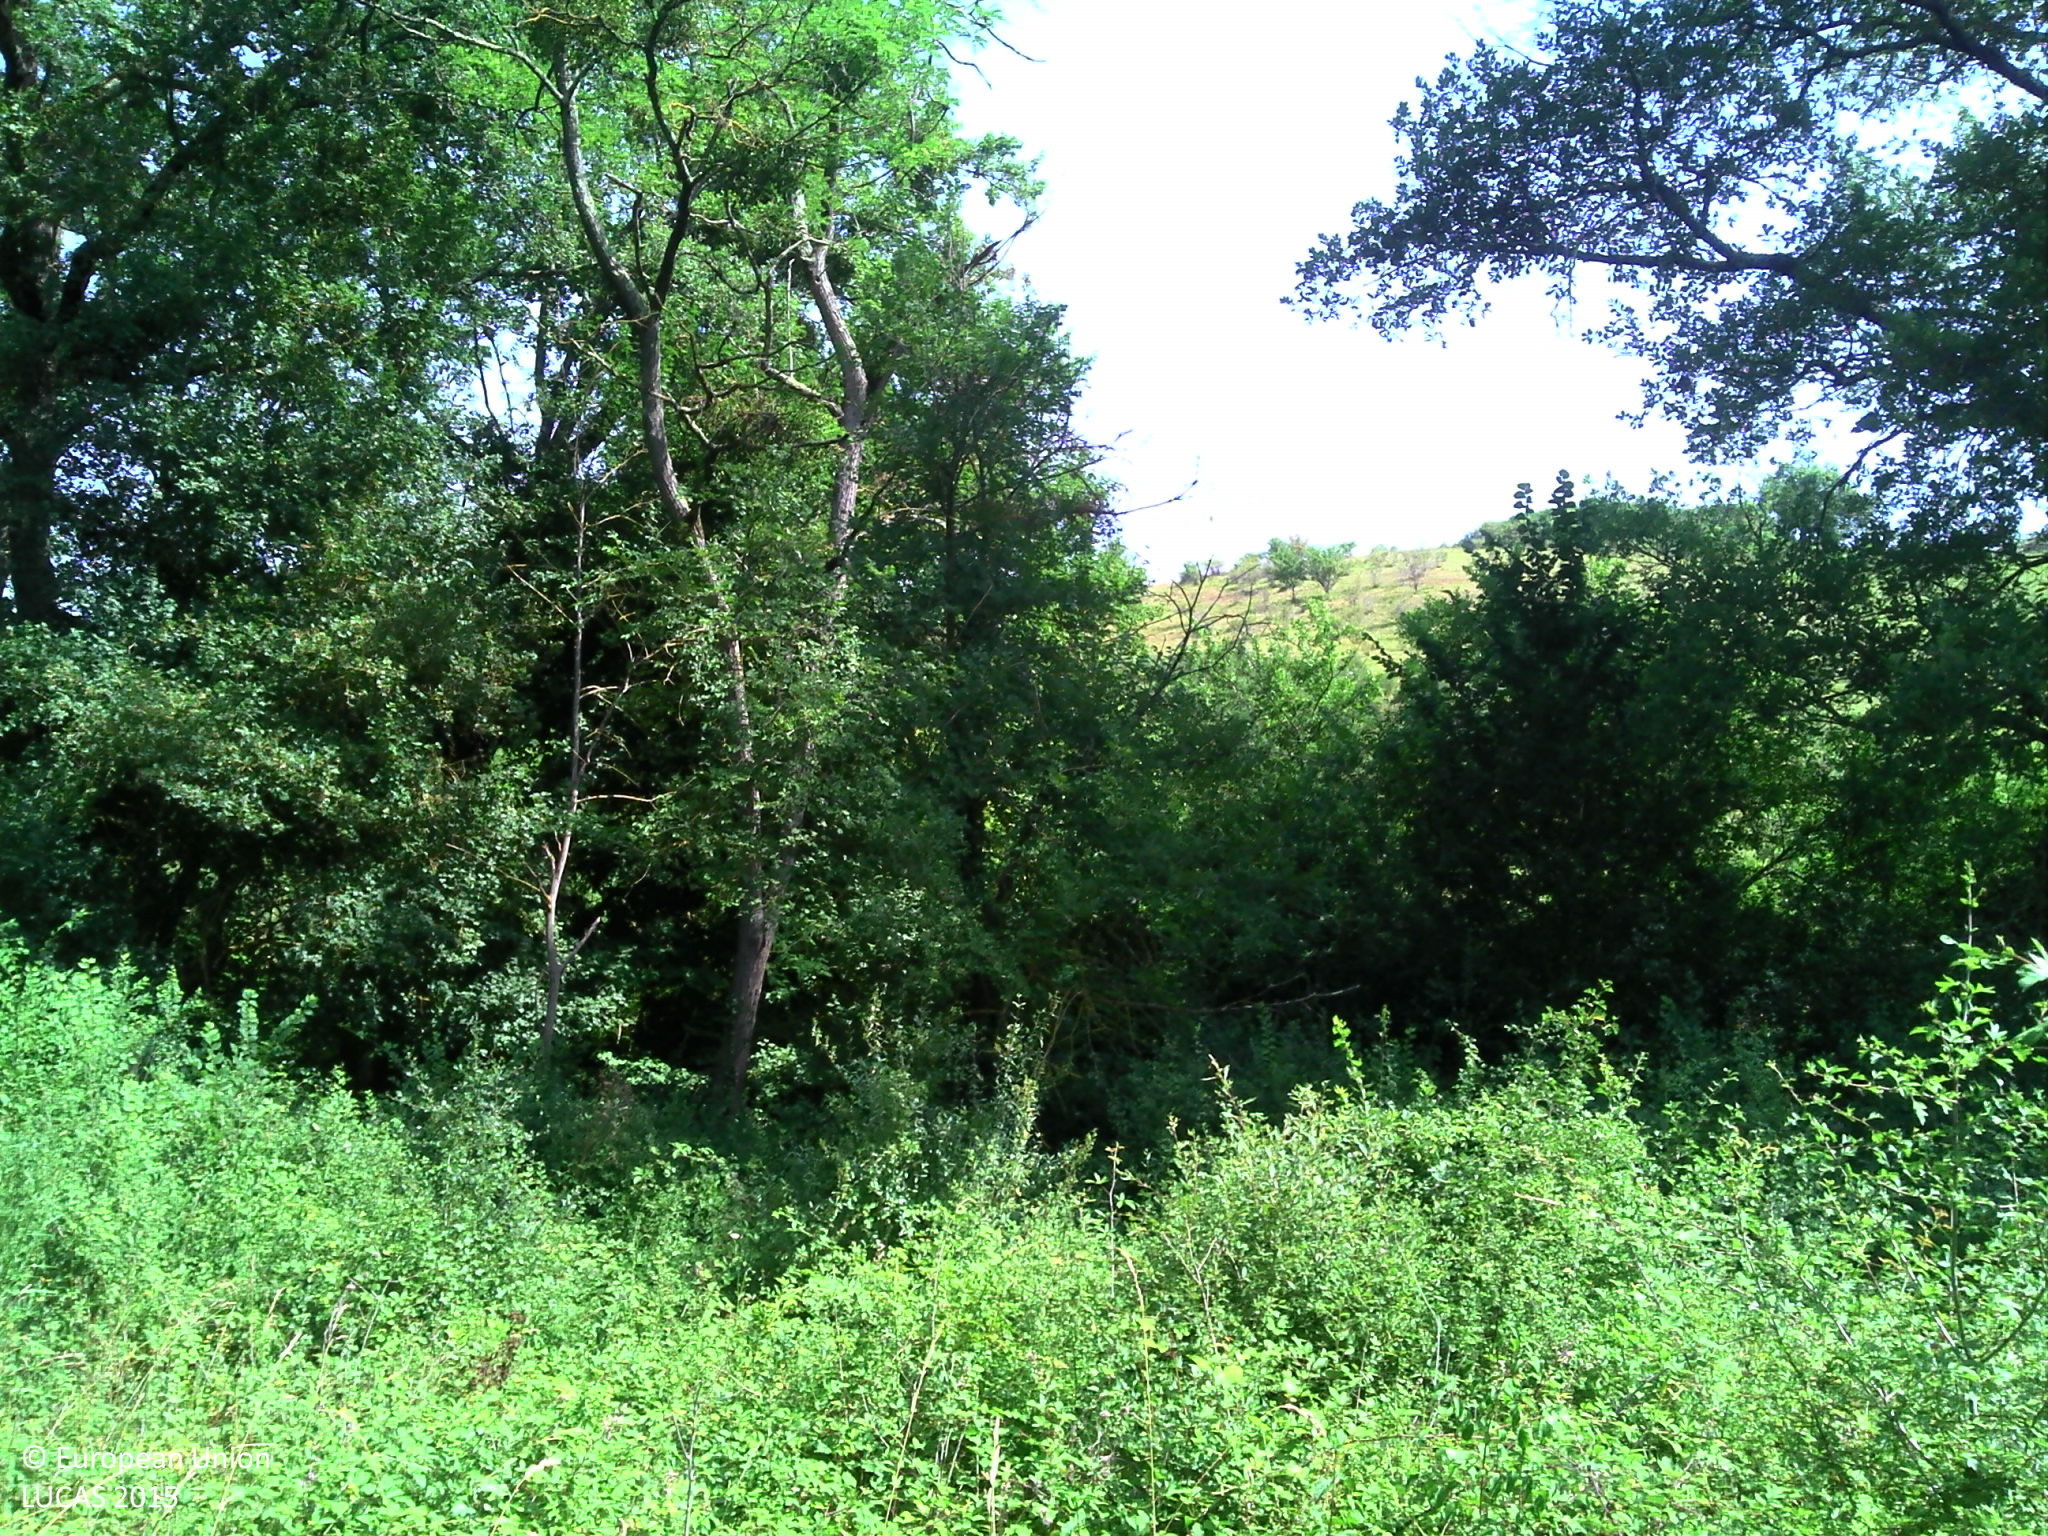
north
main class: Grassland
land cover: Spontaneously vegetated surfaces
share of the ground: > 75 %
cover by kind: herbaceous plants 100 %
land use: Semi-natural and natural areas not in use
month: July
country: FR
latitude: 43.1953
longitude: 1.4030
